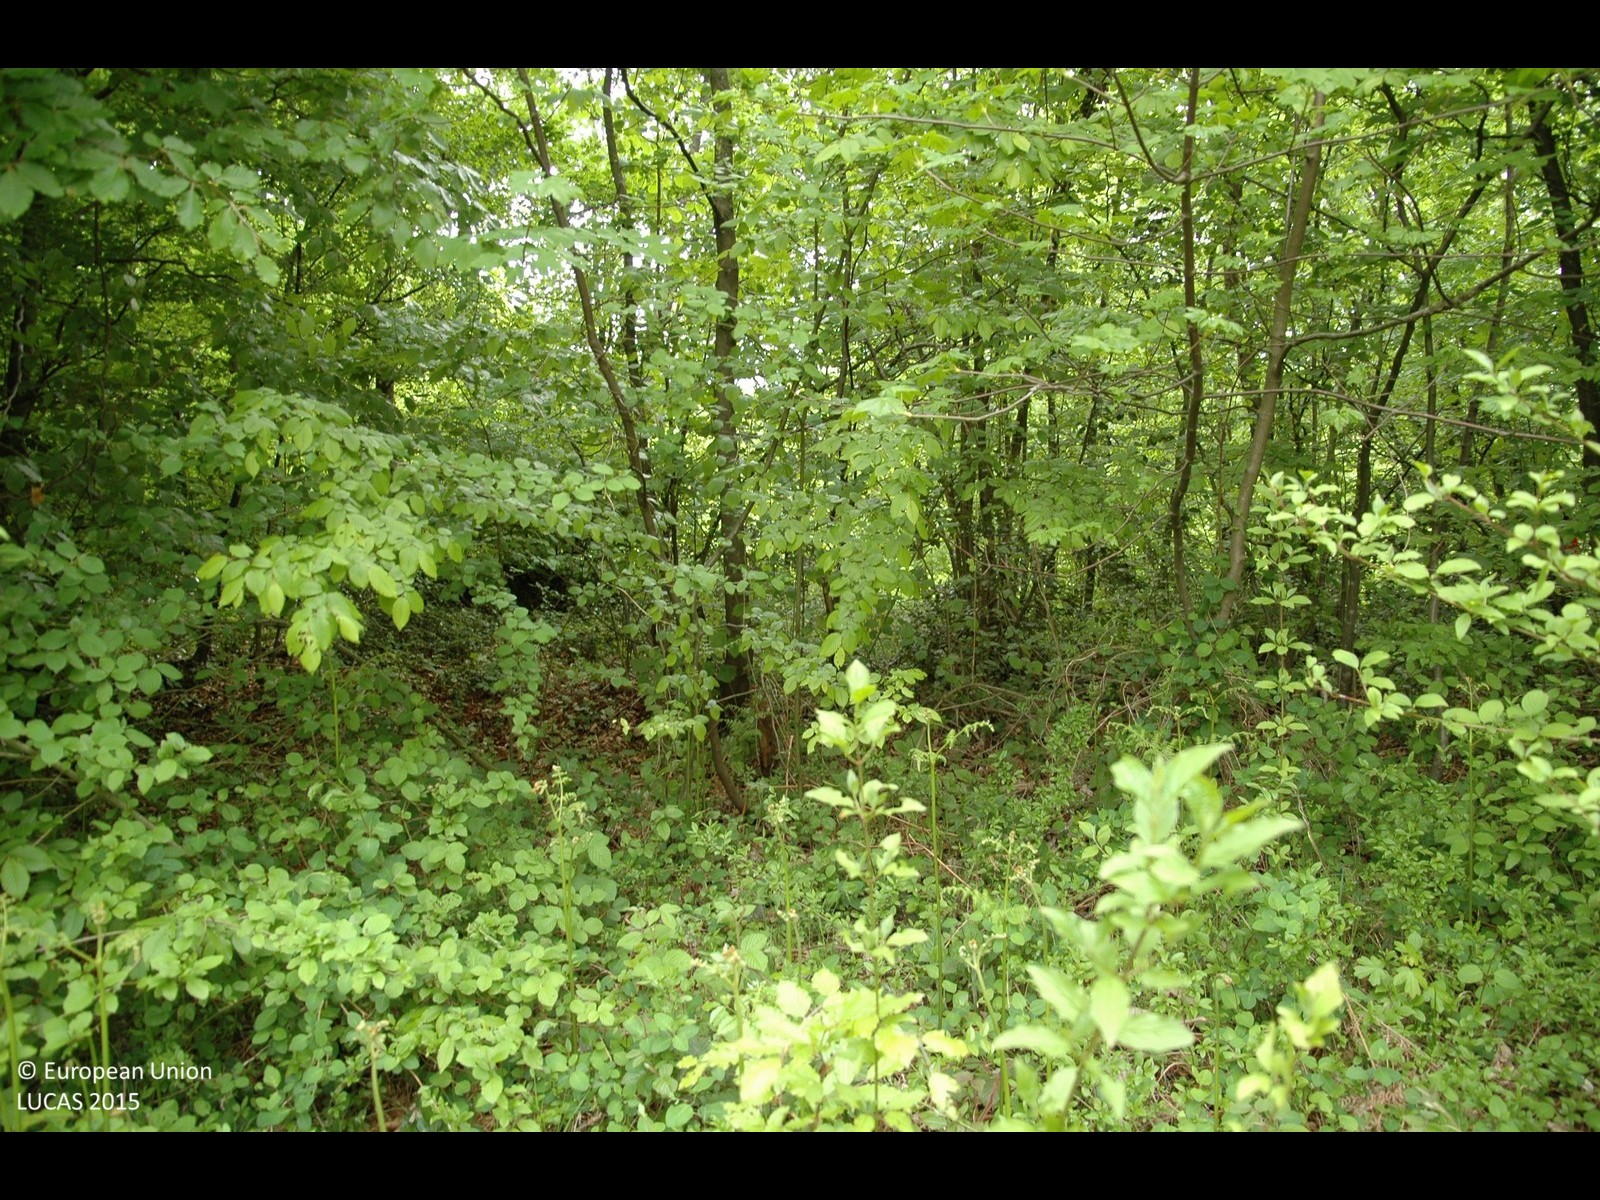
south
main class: Shrubland
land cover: Shrubland without tree cover
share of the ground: > 75 %
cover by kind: shrubs 90 %, herbaceous plants 10 %
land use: Semi-natural and natural areas not in use
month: May
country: HR
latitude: 45.8049
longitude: 15.6460
